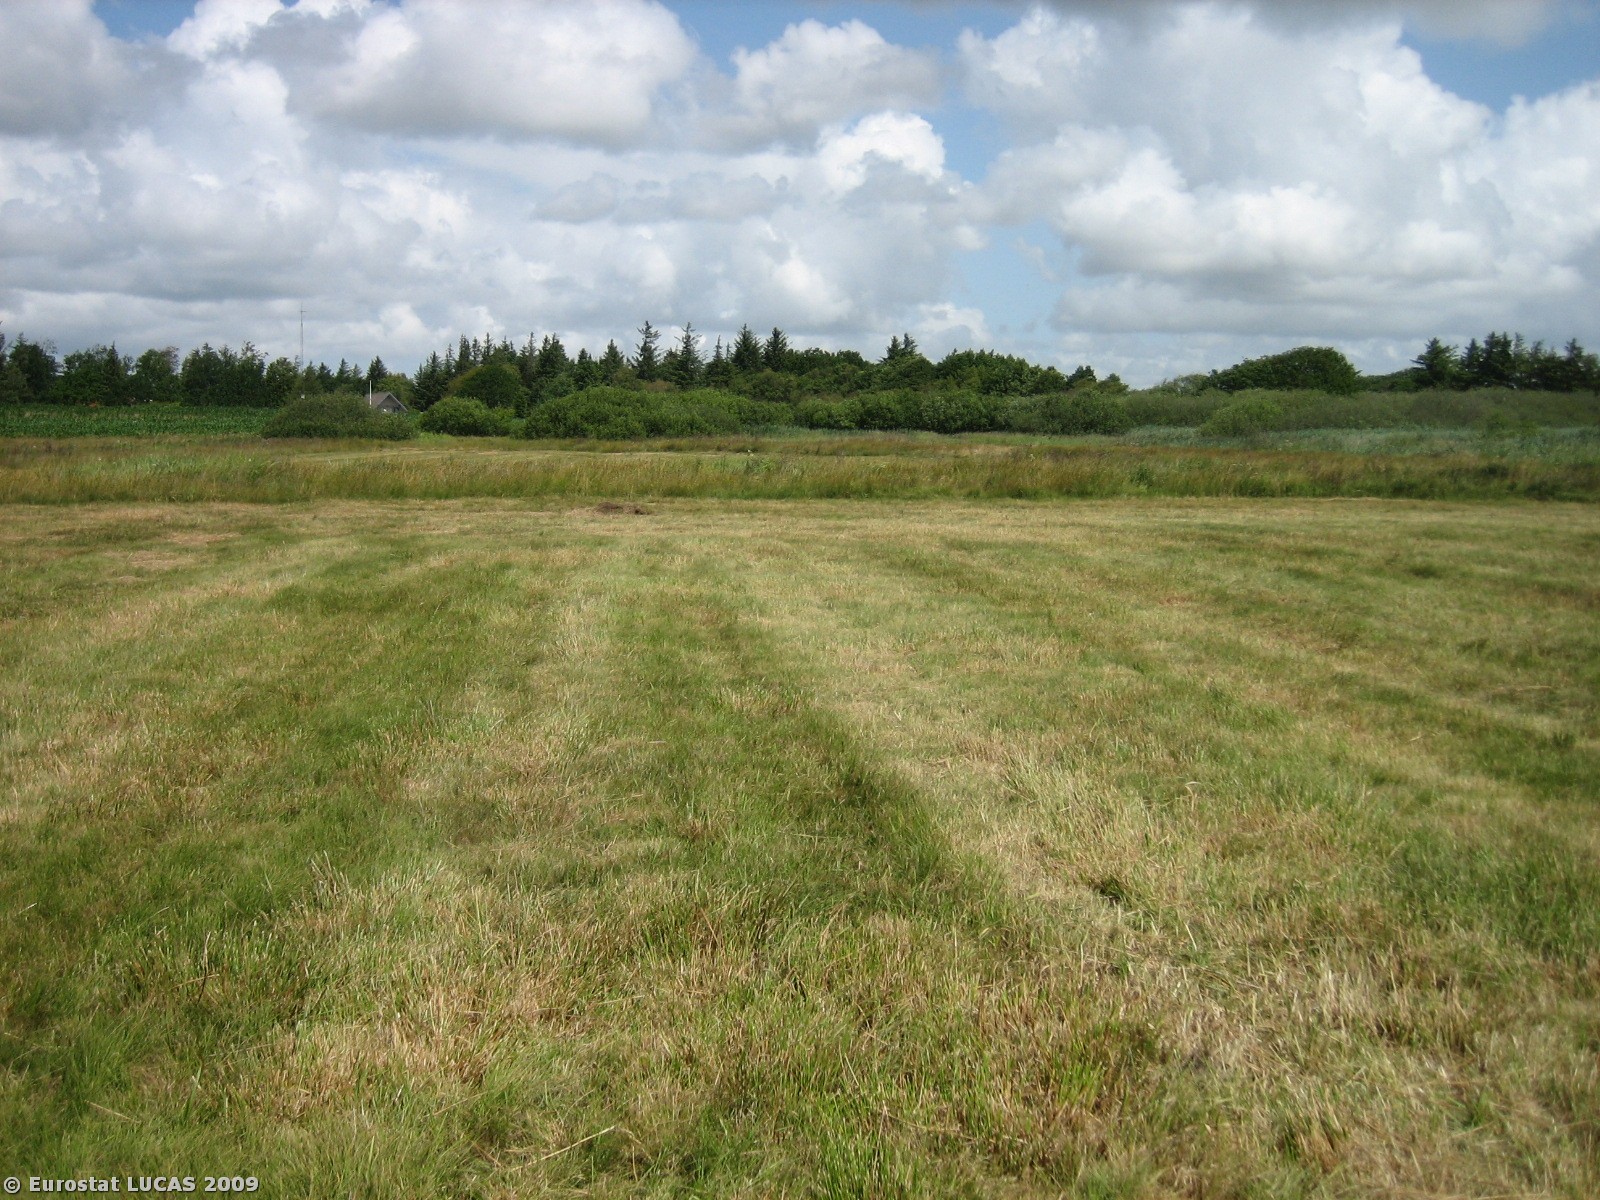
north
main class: Grassland
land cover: Grassland without tree/shrub cover
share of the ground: > 75 %
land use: Agriculture (excluding fallow land and kitchen gardens)
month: July
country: DK
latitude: 55.6208
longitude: 8.4294
